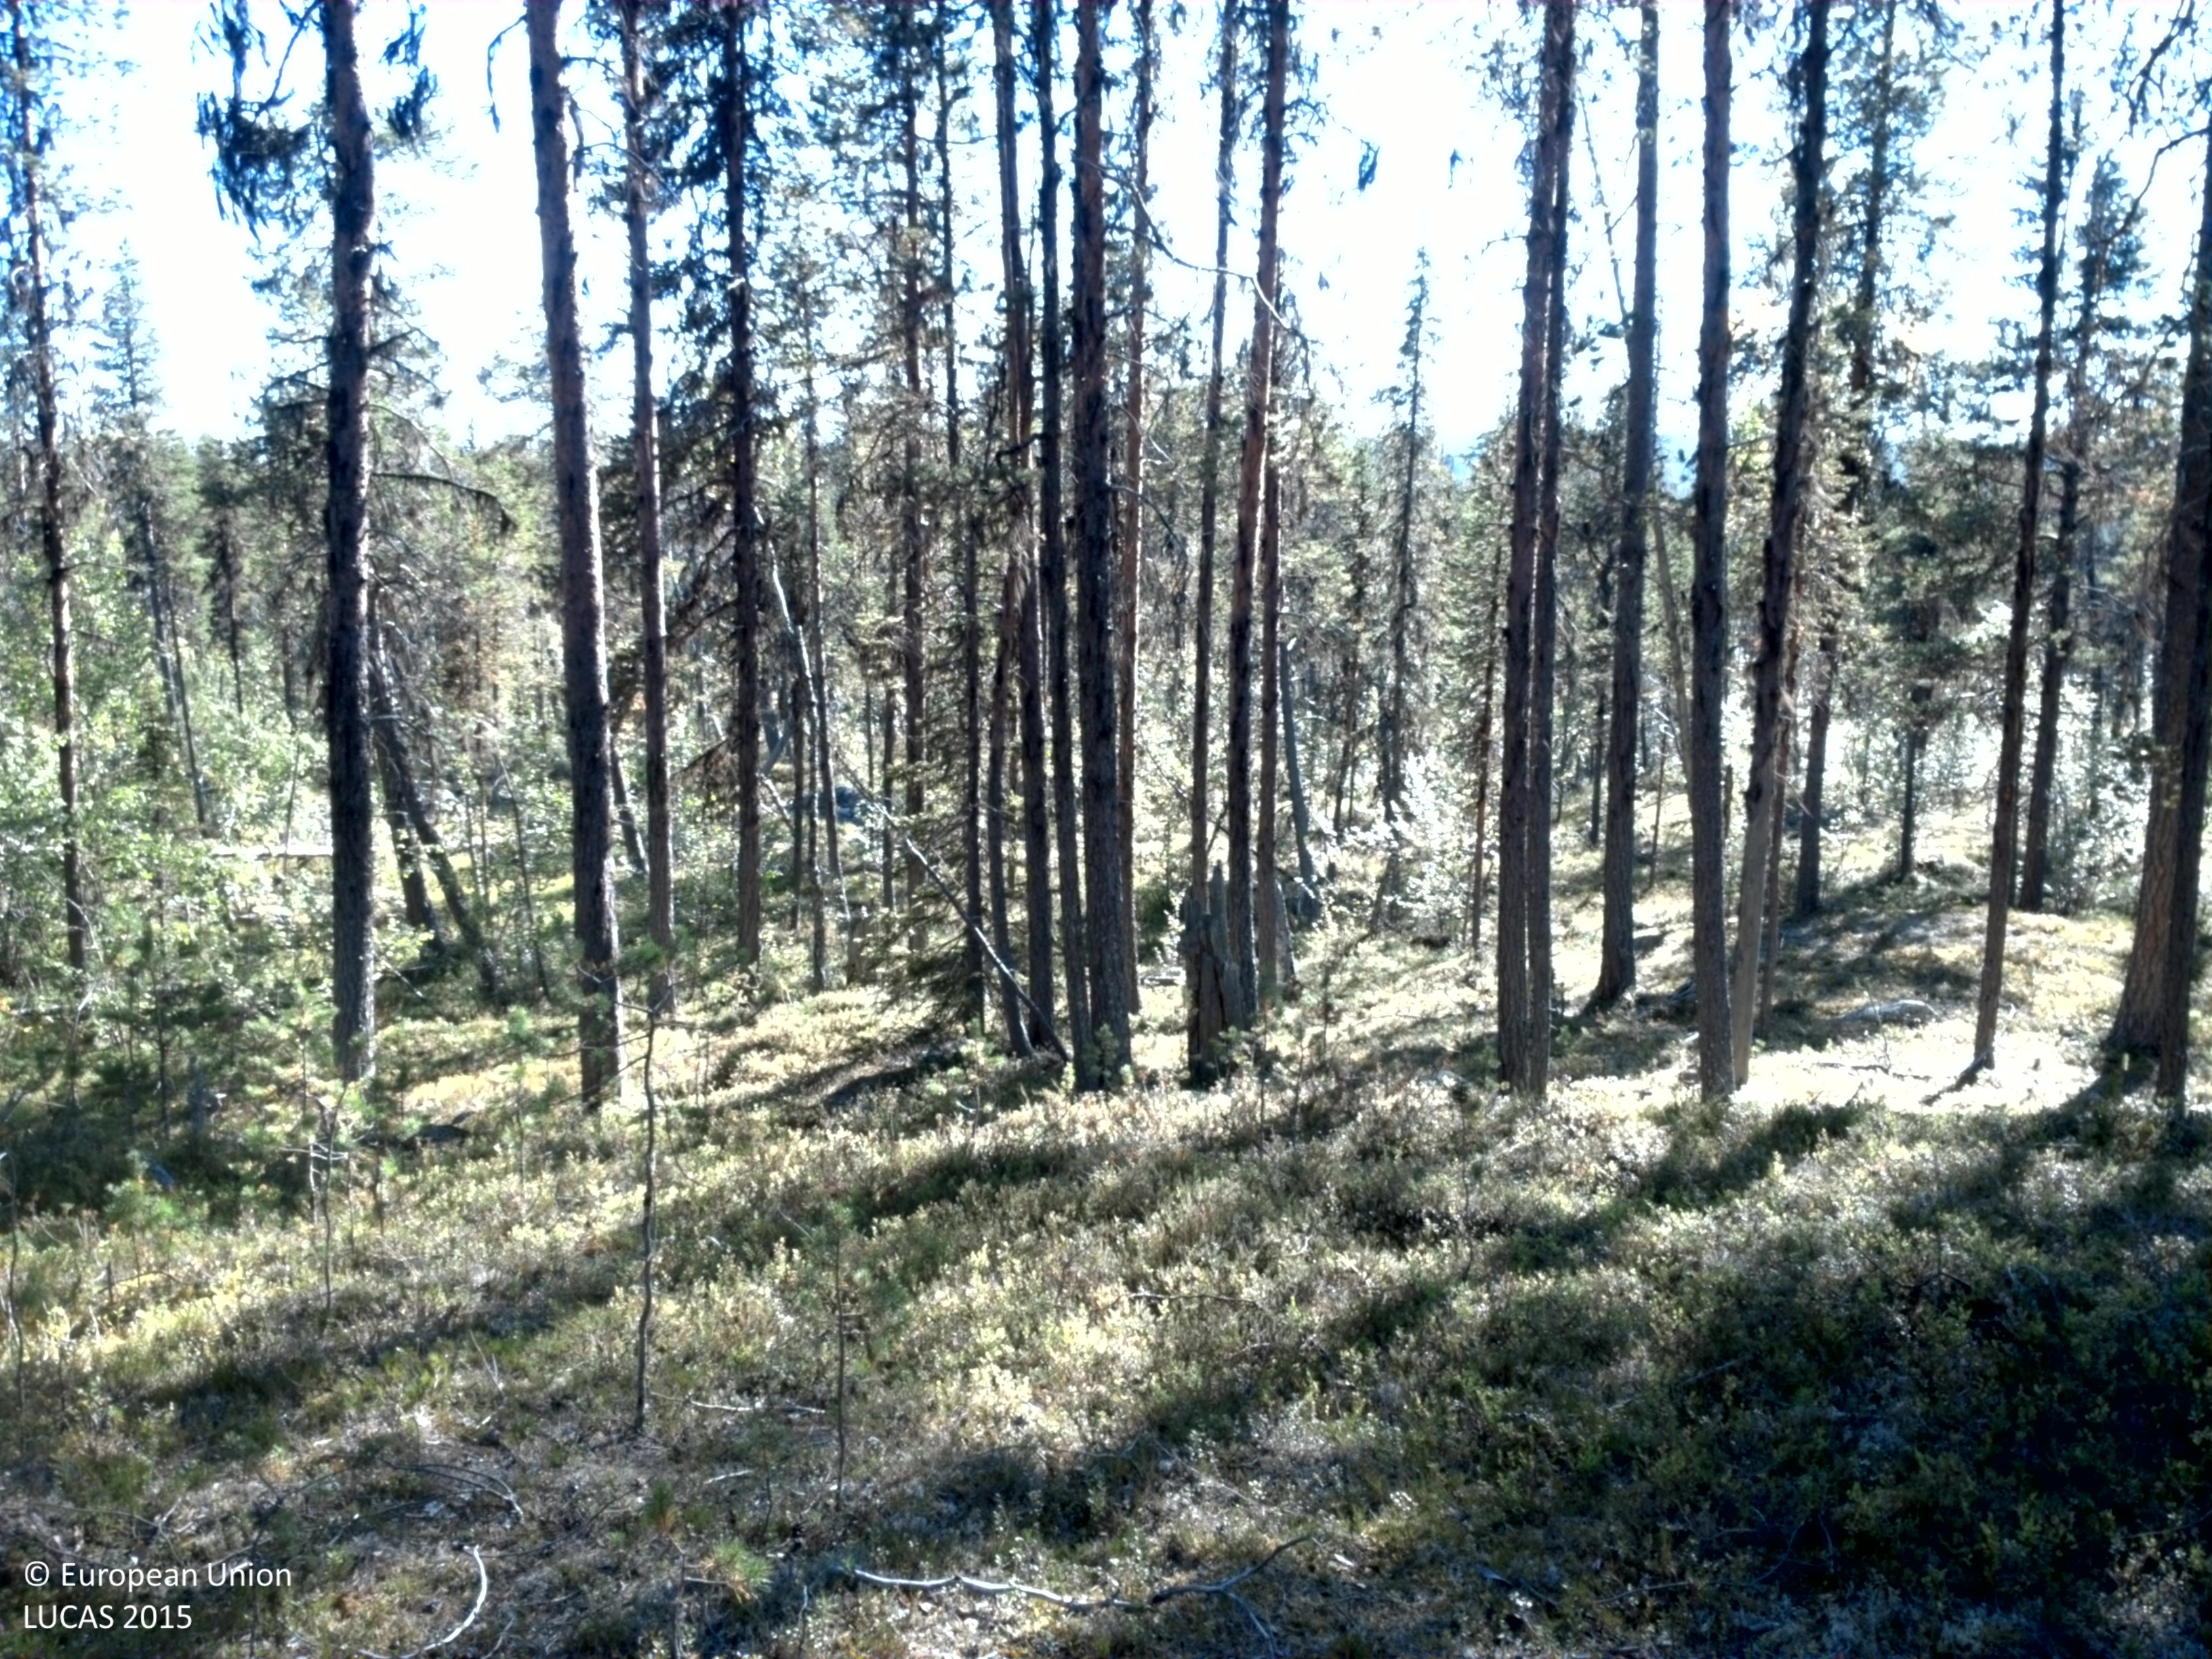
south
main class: Woodland
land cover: Pine dominated coniferous woodland
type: boreal forest
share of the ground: 25 - 50 %
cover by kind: shrubs 55 %, coniferous forest trees 35 %, broadleaved forest trees 5 %, lichens and mosses 5 %
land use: Forestry
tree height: > 5 m
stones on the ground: 25 - 50 %
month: August
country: SE
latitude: 66.7471
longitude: 19.0060
